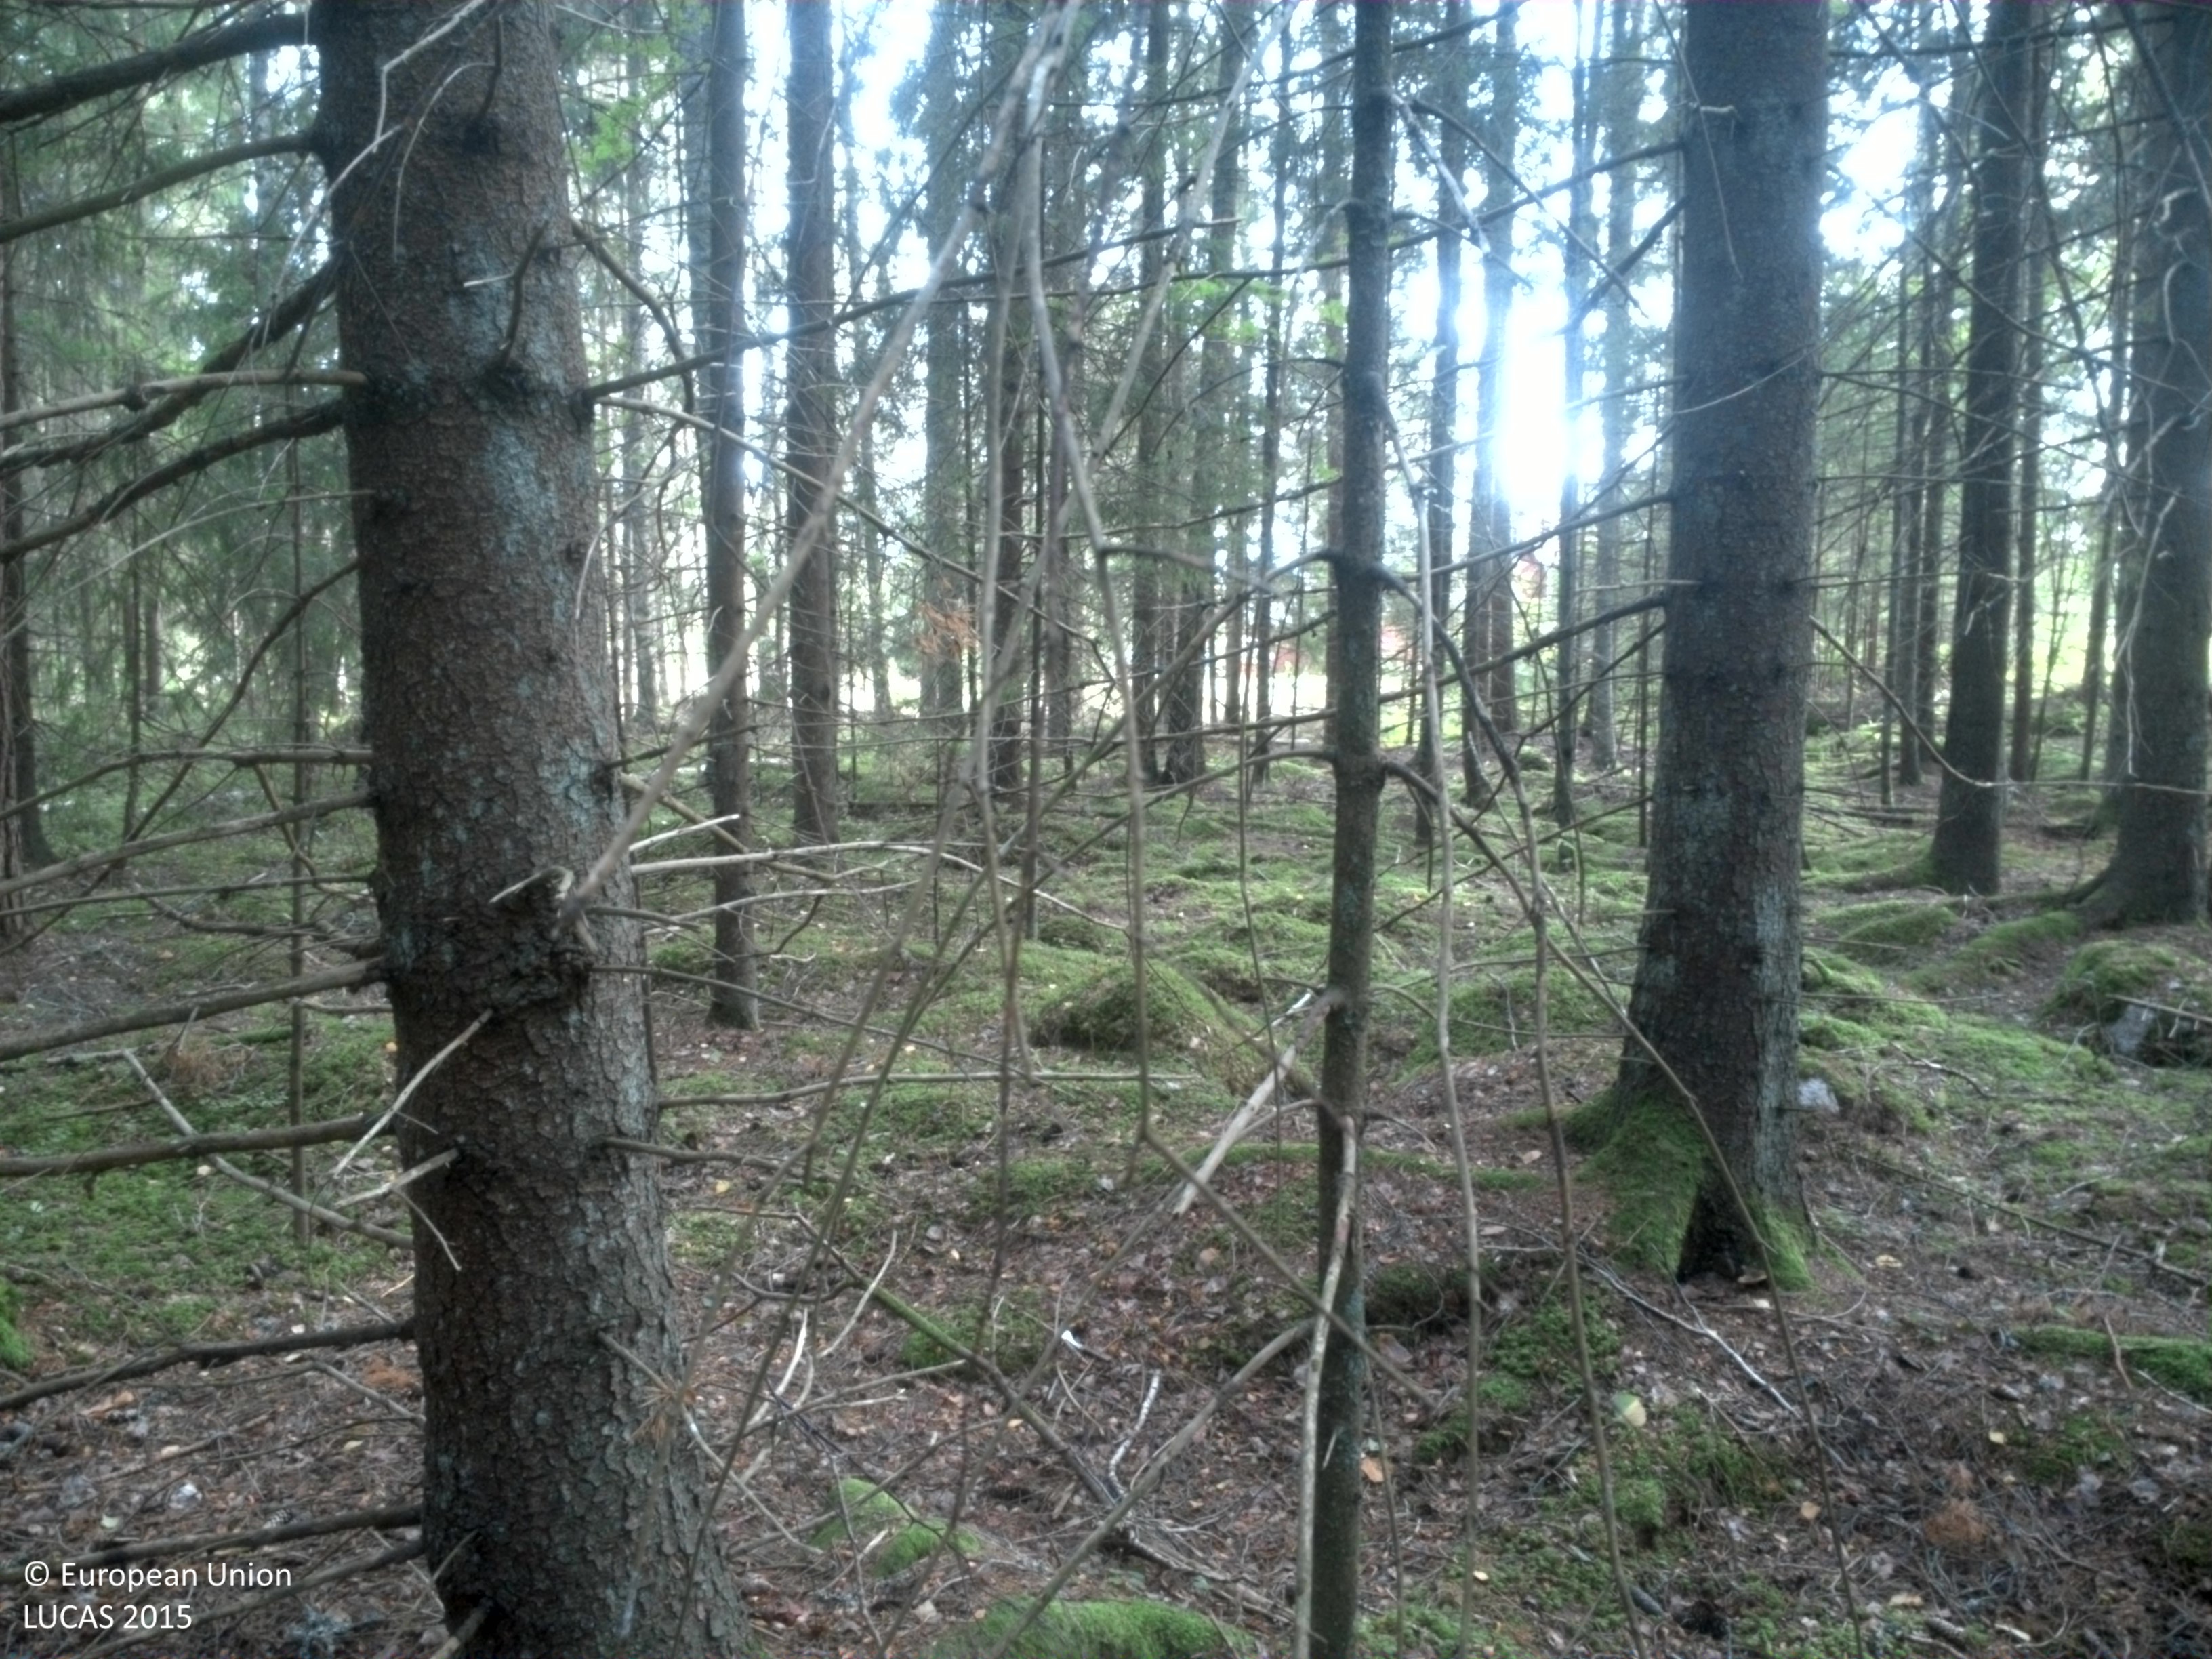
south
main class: Woodland
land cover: Spruce dominated coniferous woodland
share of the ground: > 75 %
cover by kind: coniferous forest trees 70 %, lichens and mosses 15 %, broadleaved forest trees 10 %, shrubs 5 %
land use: Forestry
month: September
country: SE
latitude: 59.4910
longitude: 15.6246
